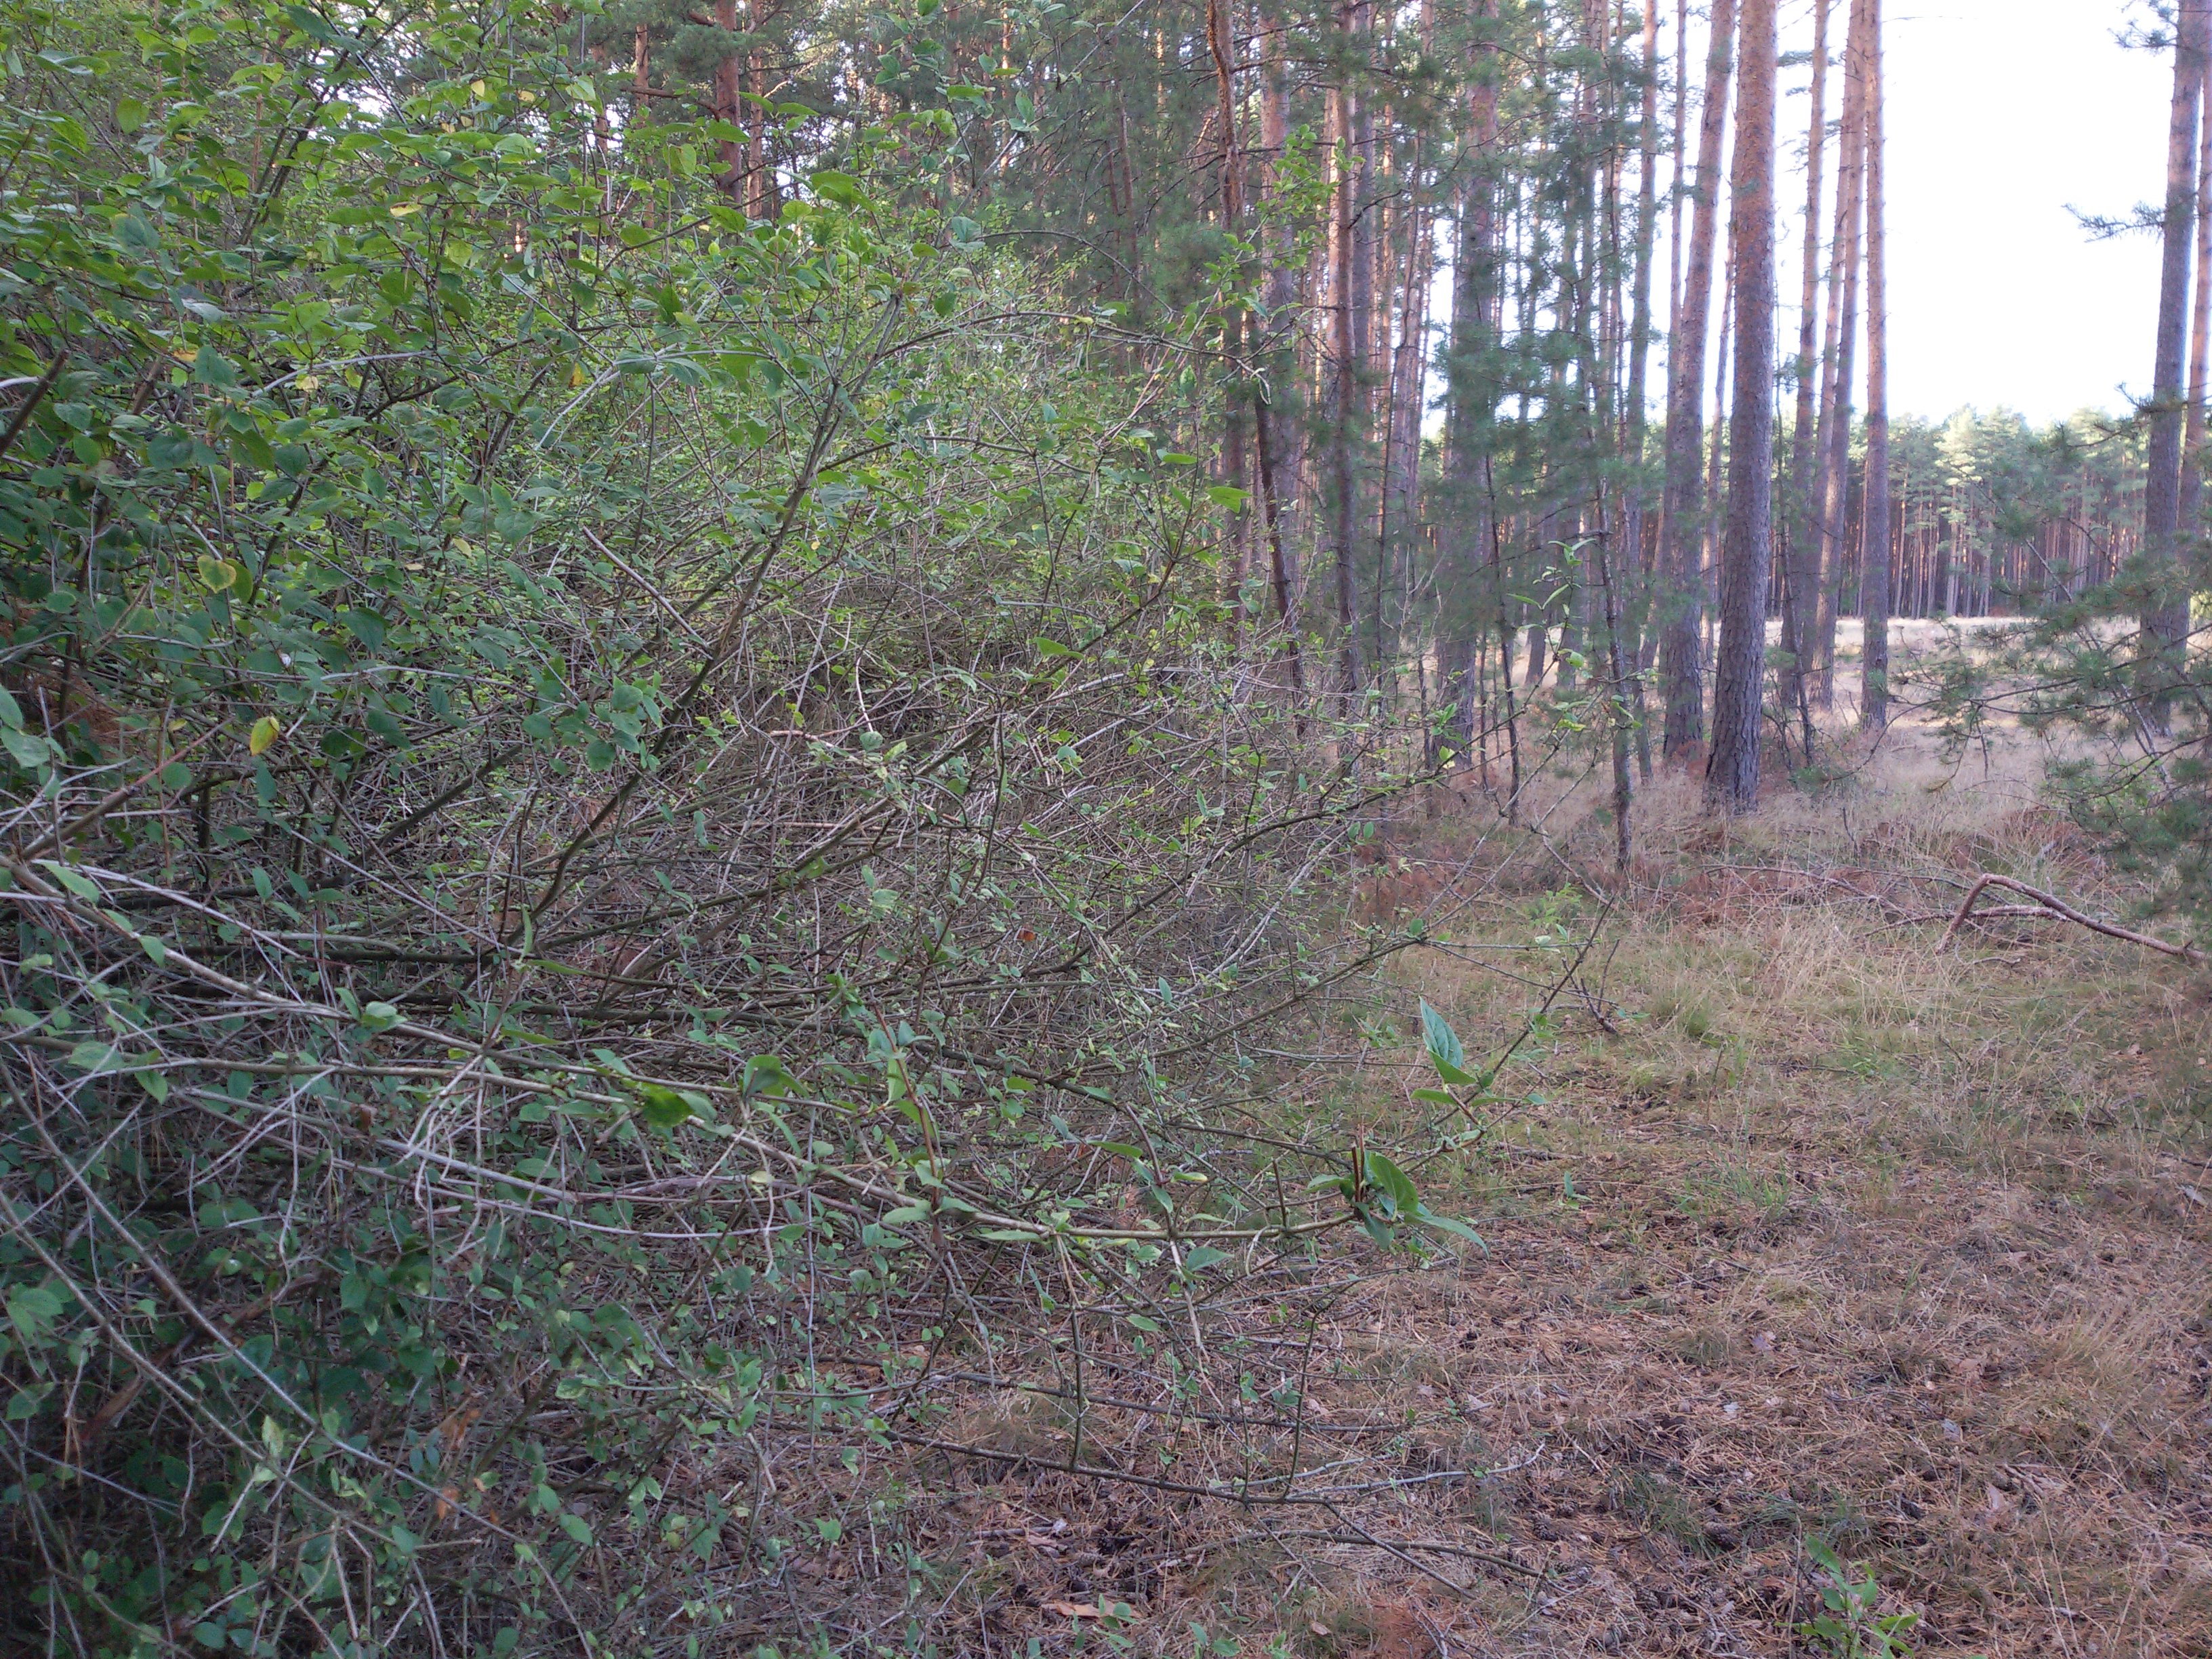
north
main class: Woodland
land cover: Pine dominated coniferous woodland
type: hemiboreal forest and nemoral coniferous forest and mixed broadleaved-coniferous forest
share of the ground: 50 - 75 %
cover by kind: coniferous forest trees 45 %, shrubs 25 %, herbaceous plants 15 %, broadleaved forest trees 10 %, lichens and mosses 5 %
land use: Forestry
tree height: > 5 m
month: September
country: PL
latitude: 53.0721
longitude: 17.6098
